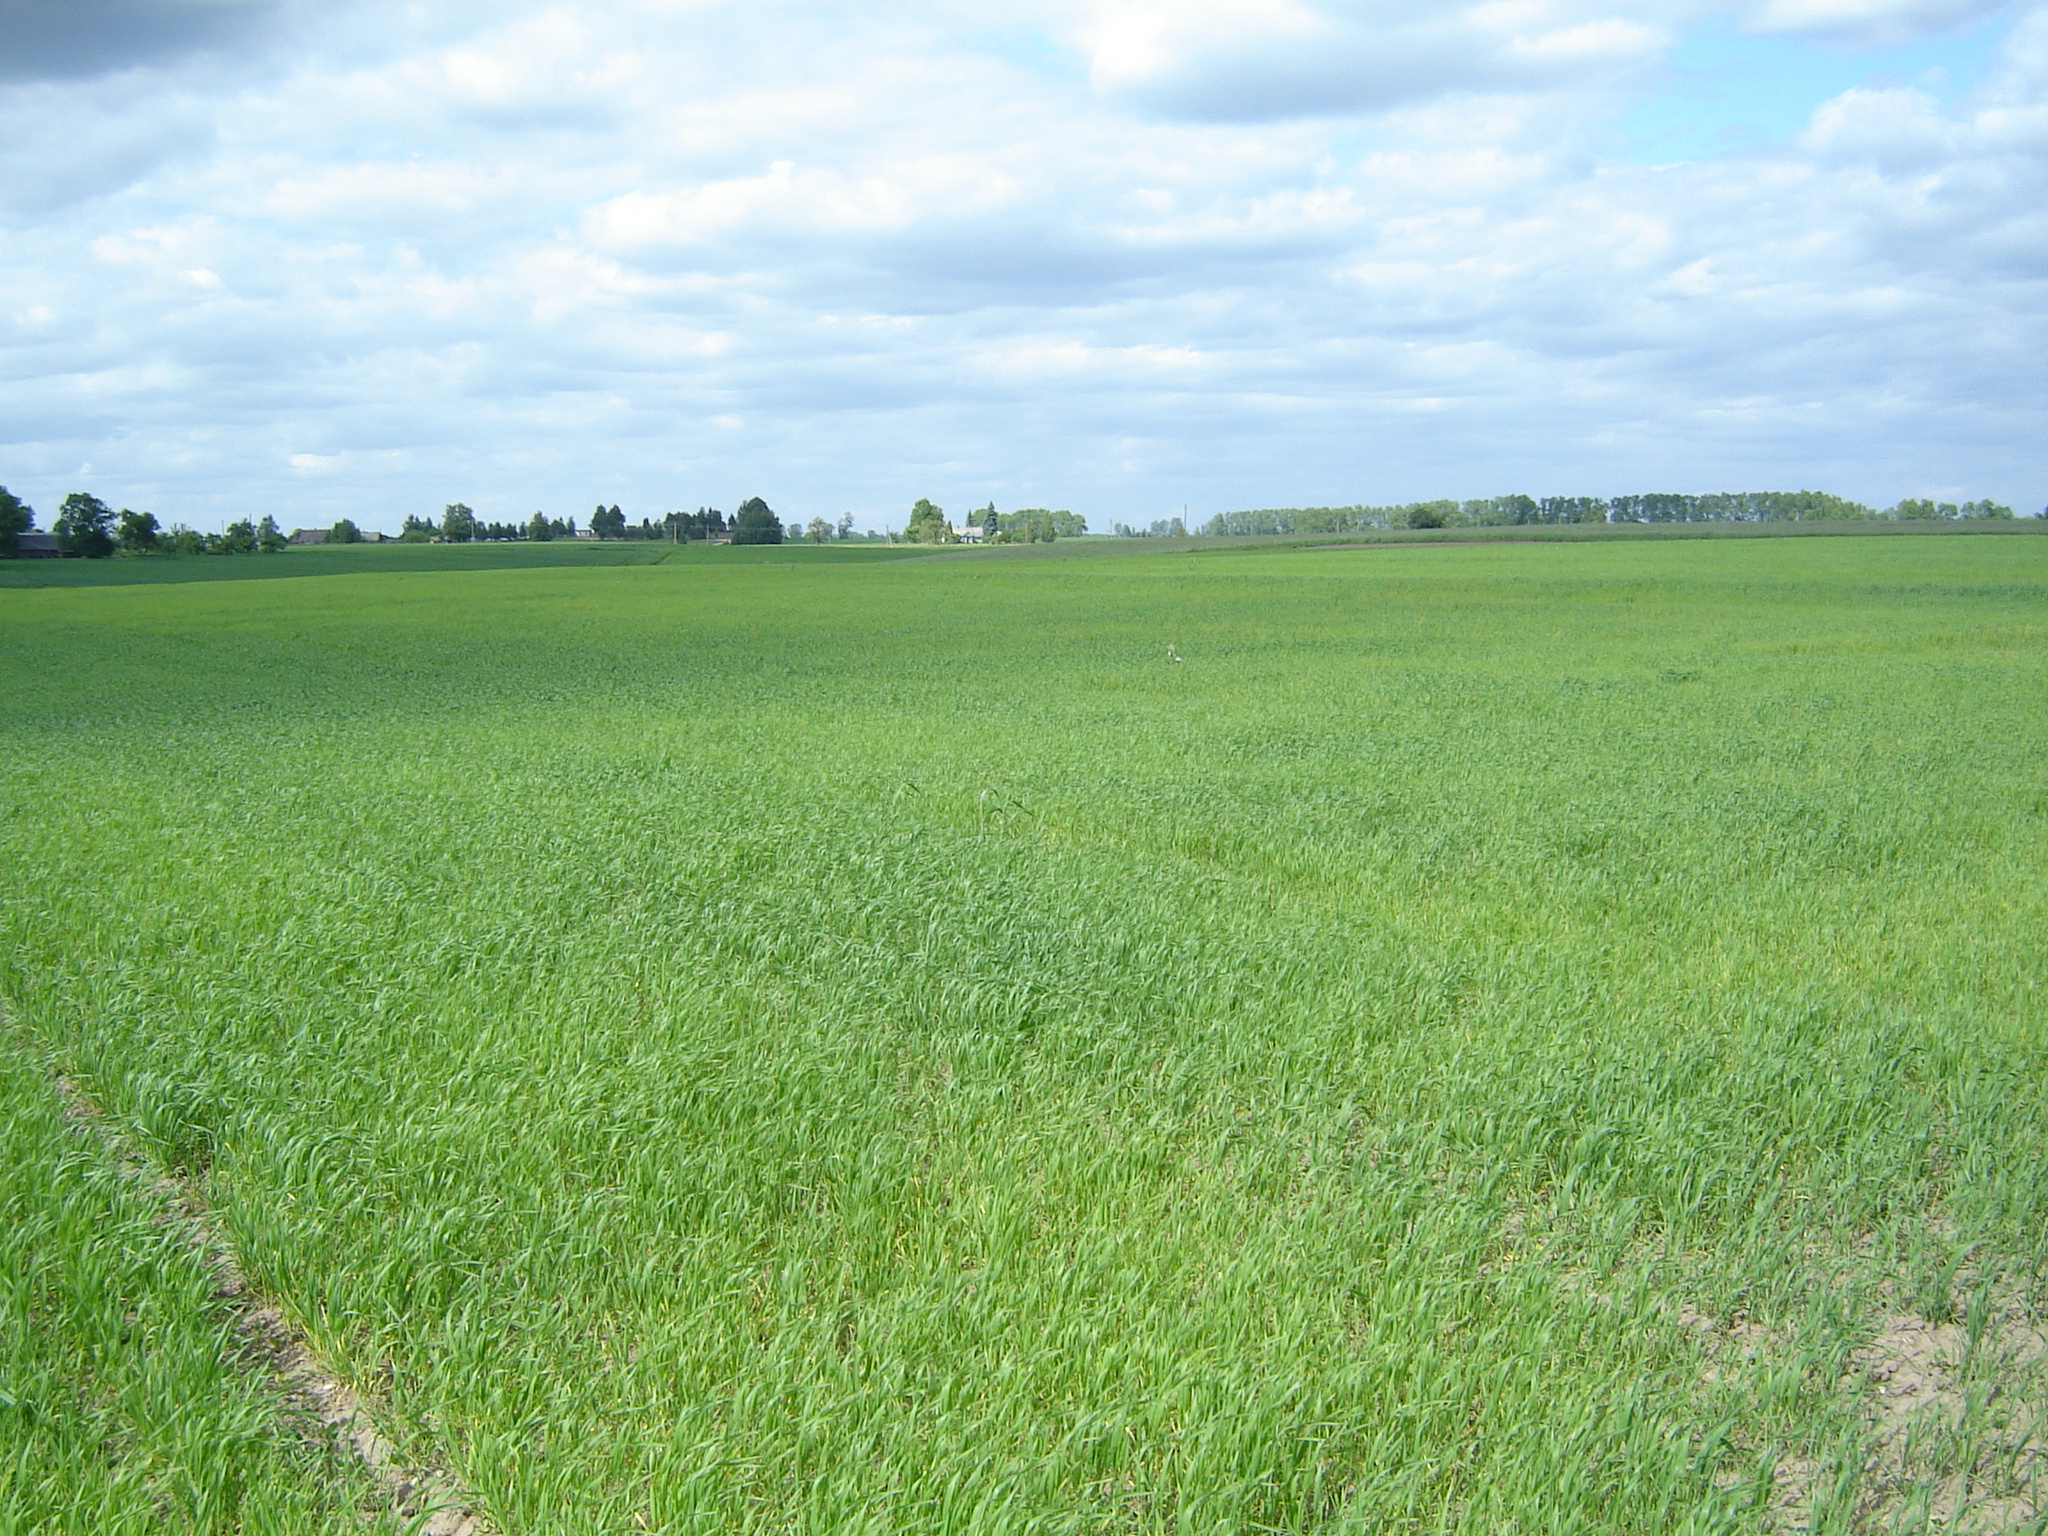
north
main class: Cropland
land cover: Common wheat
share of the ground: > 75 %
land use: Agriculture (excluding fallow land and kitchen gardens)
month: June
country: LT
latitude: 55.3849
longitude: 24.7383
